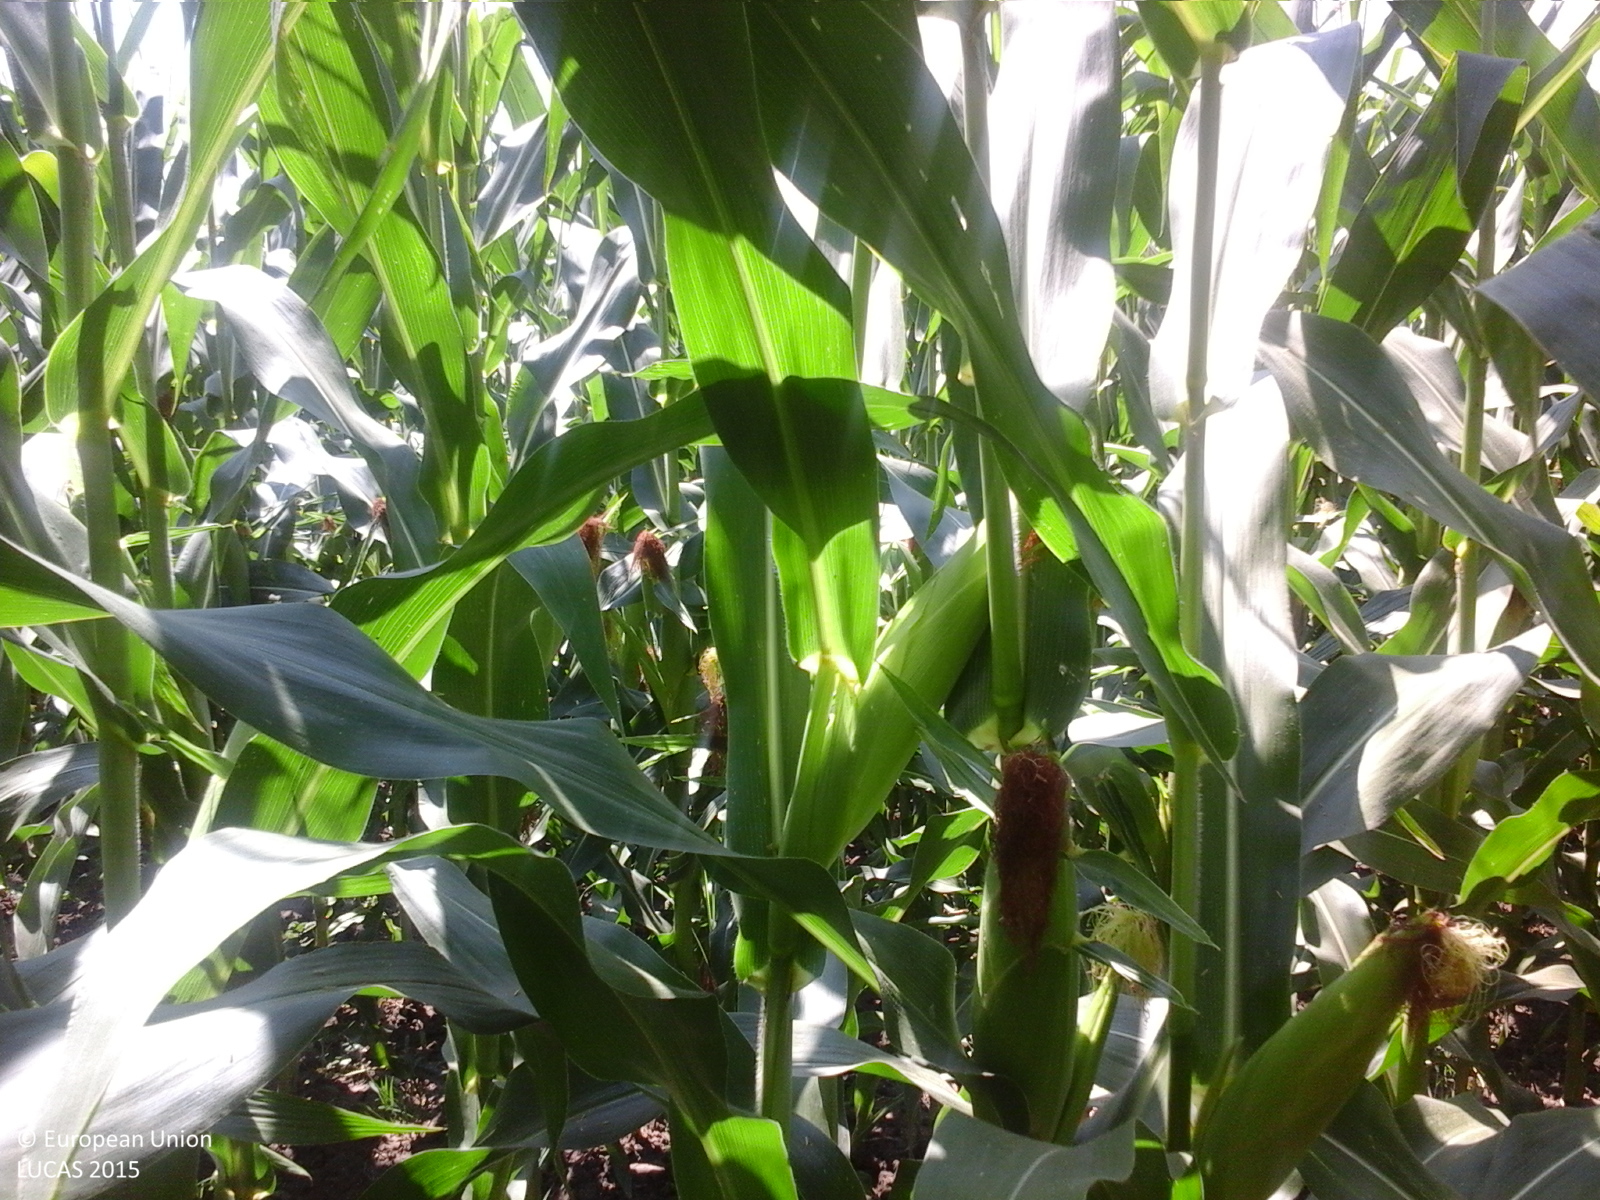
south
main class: Cropland
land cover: Maize
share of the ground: > 75 %
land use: Agriculture (excluding fallow land and kitchen gardens)
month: July
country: RO
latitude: 44.5188
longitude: 27.1037
